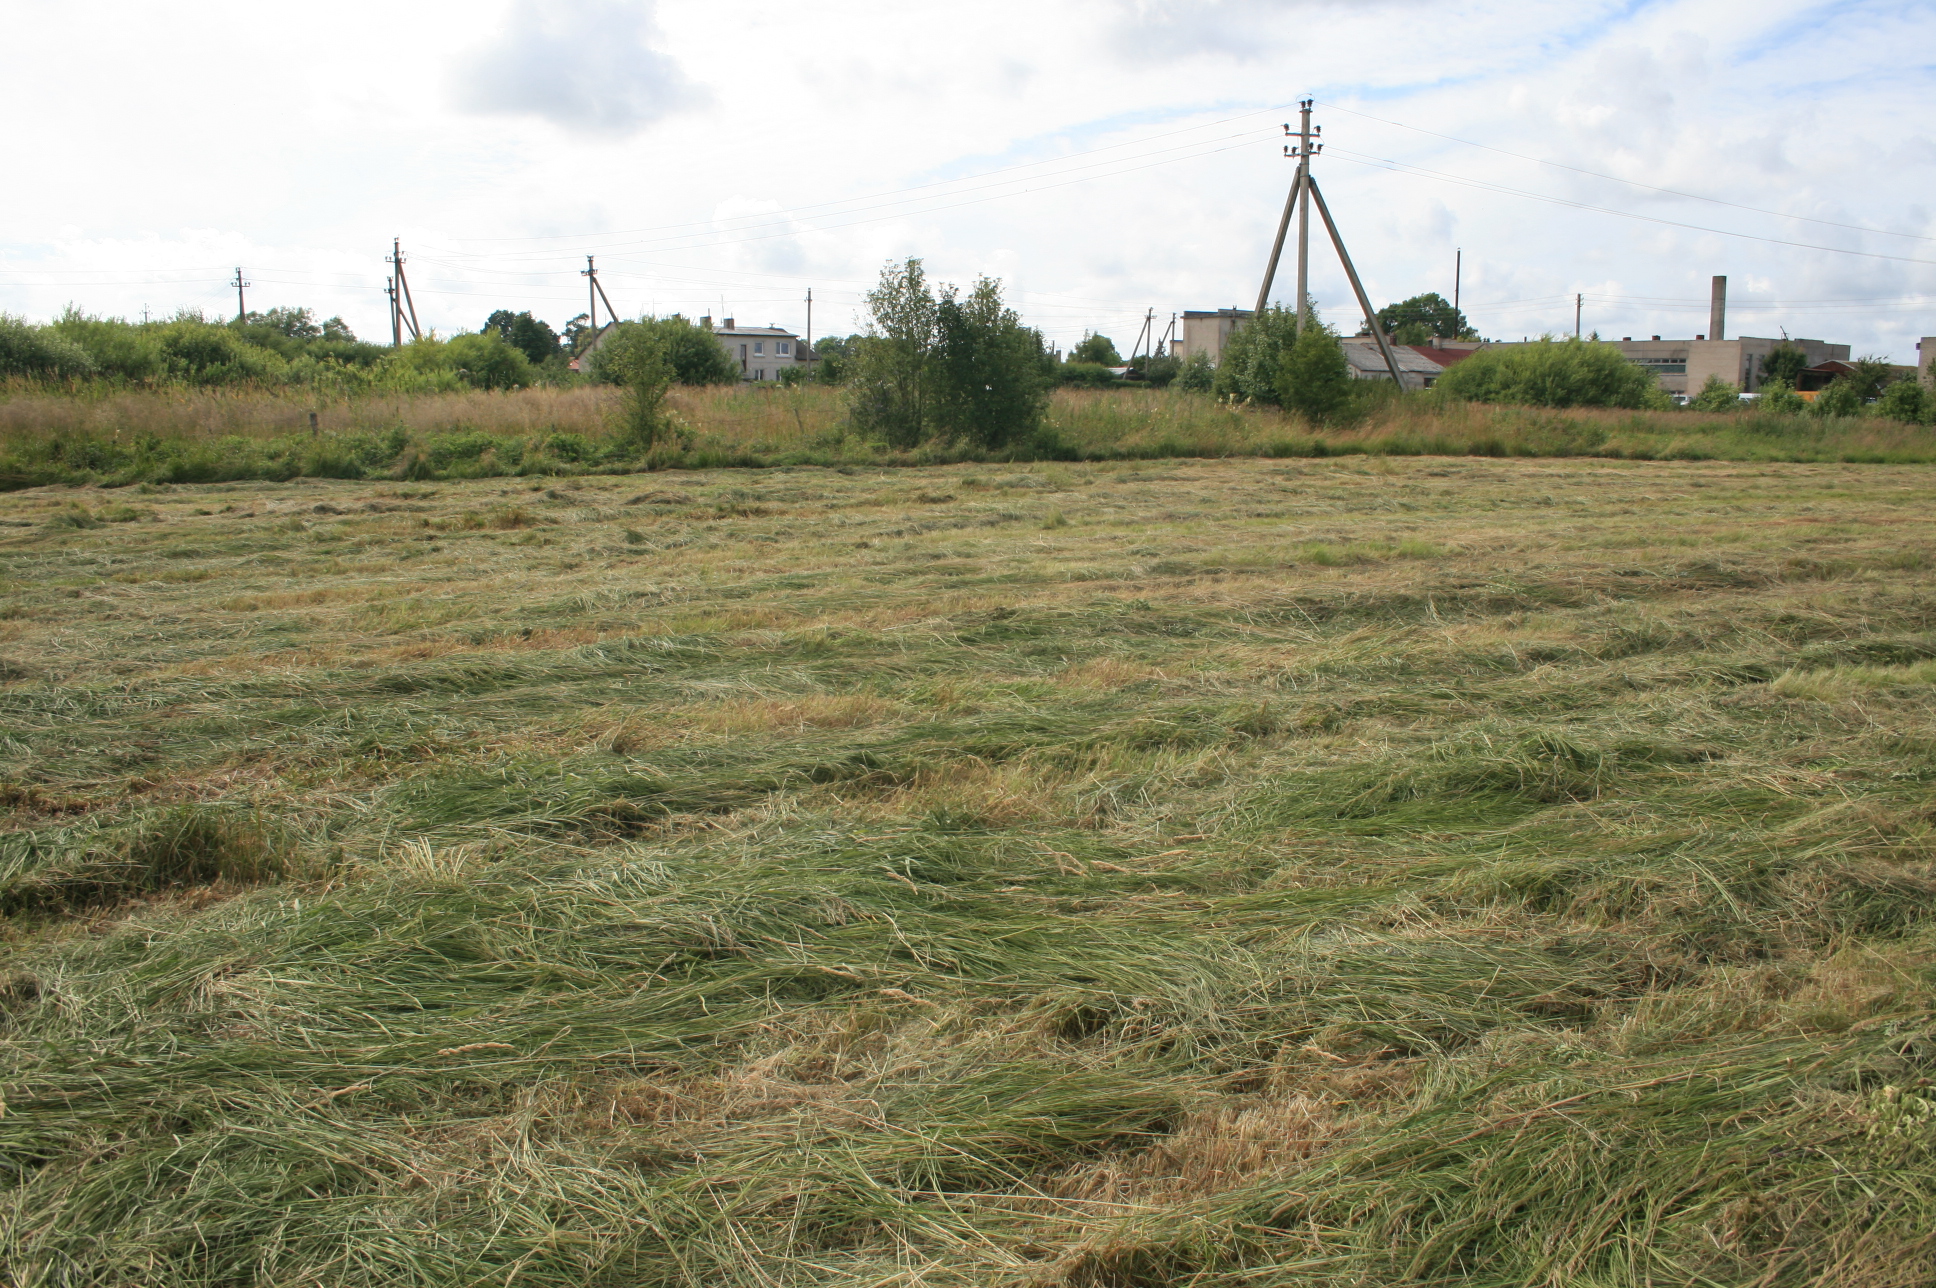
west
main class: Grassland
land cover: Grassland without tree/shrub cover
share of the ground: > 75 %
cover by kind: herbaceous plants 100 %
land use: Agriculture (excluding fallow land and kitchen gardens)
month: July
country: LT
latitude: 55.5377
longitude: 21.3416
